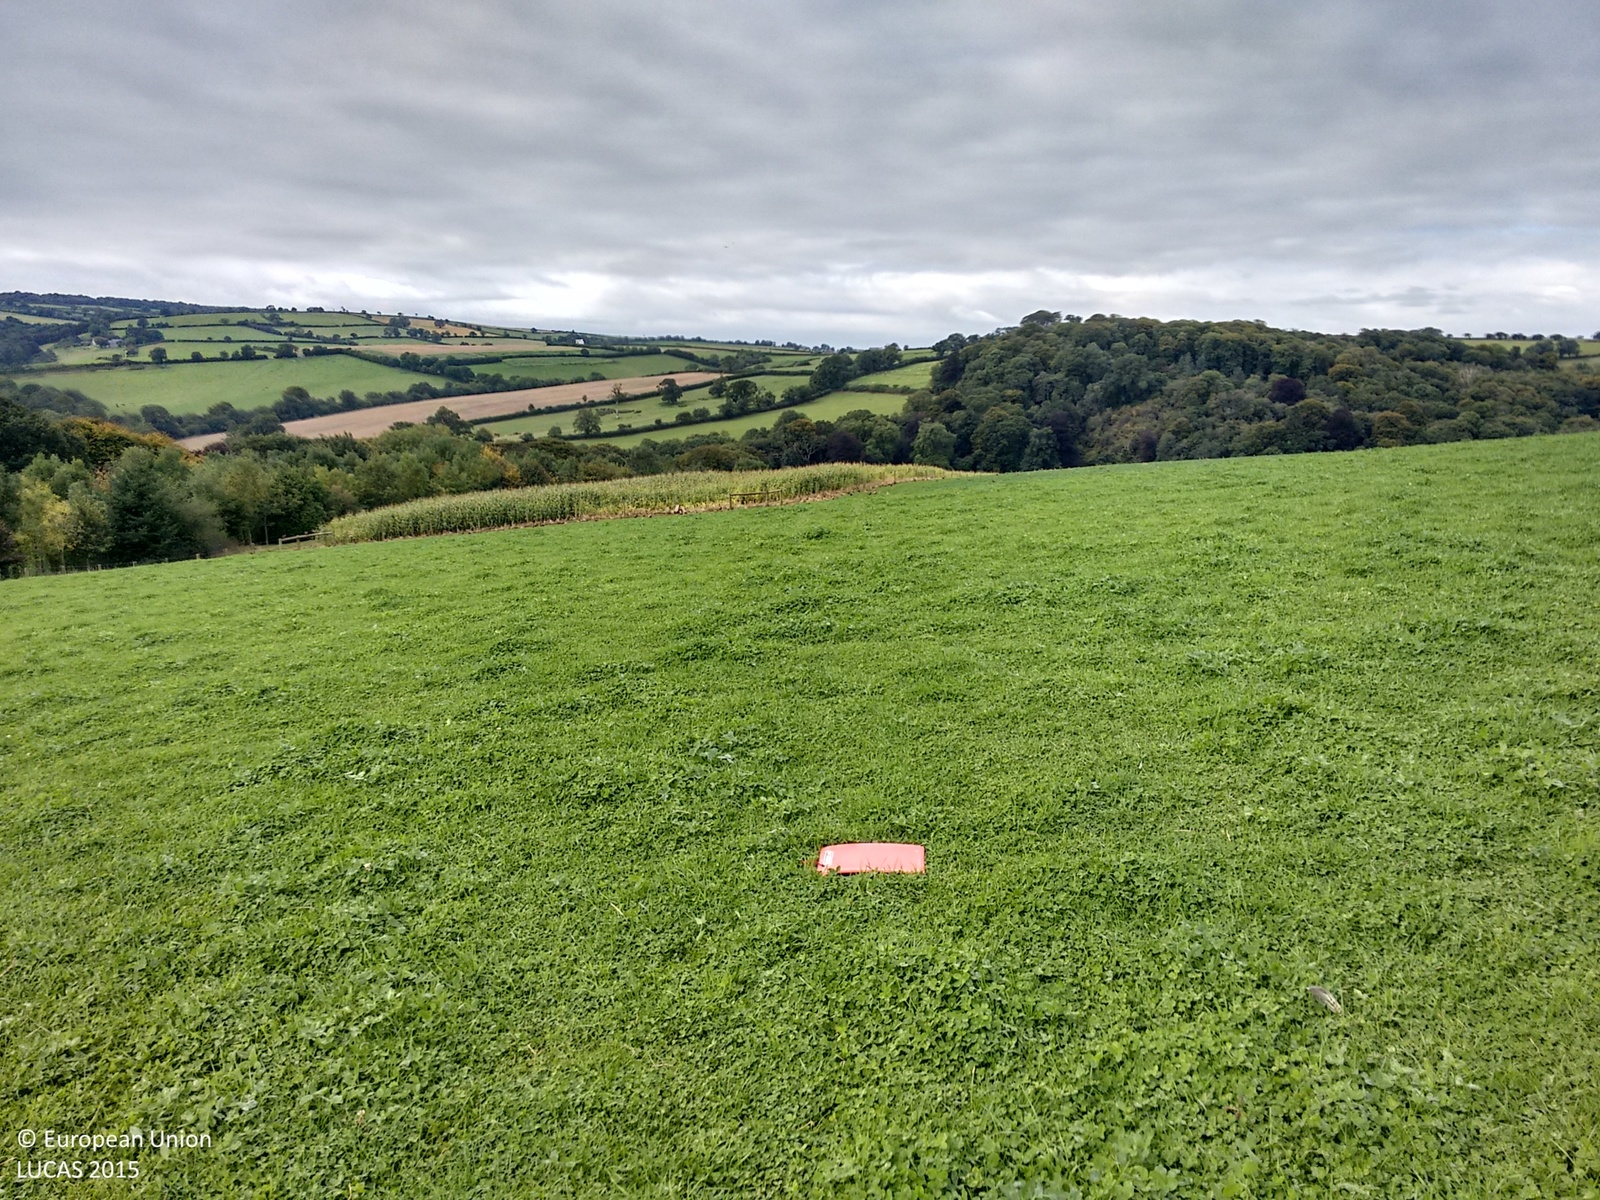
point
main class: Cropland
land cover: Other leguminous and mixtures for fodder
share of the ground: > 75 %
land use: Agriculture (excluding fallow land and kitchen gardens)
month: September
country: GB
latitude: 50.6381
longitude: -4.2241
